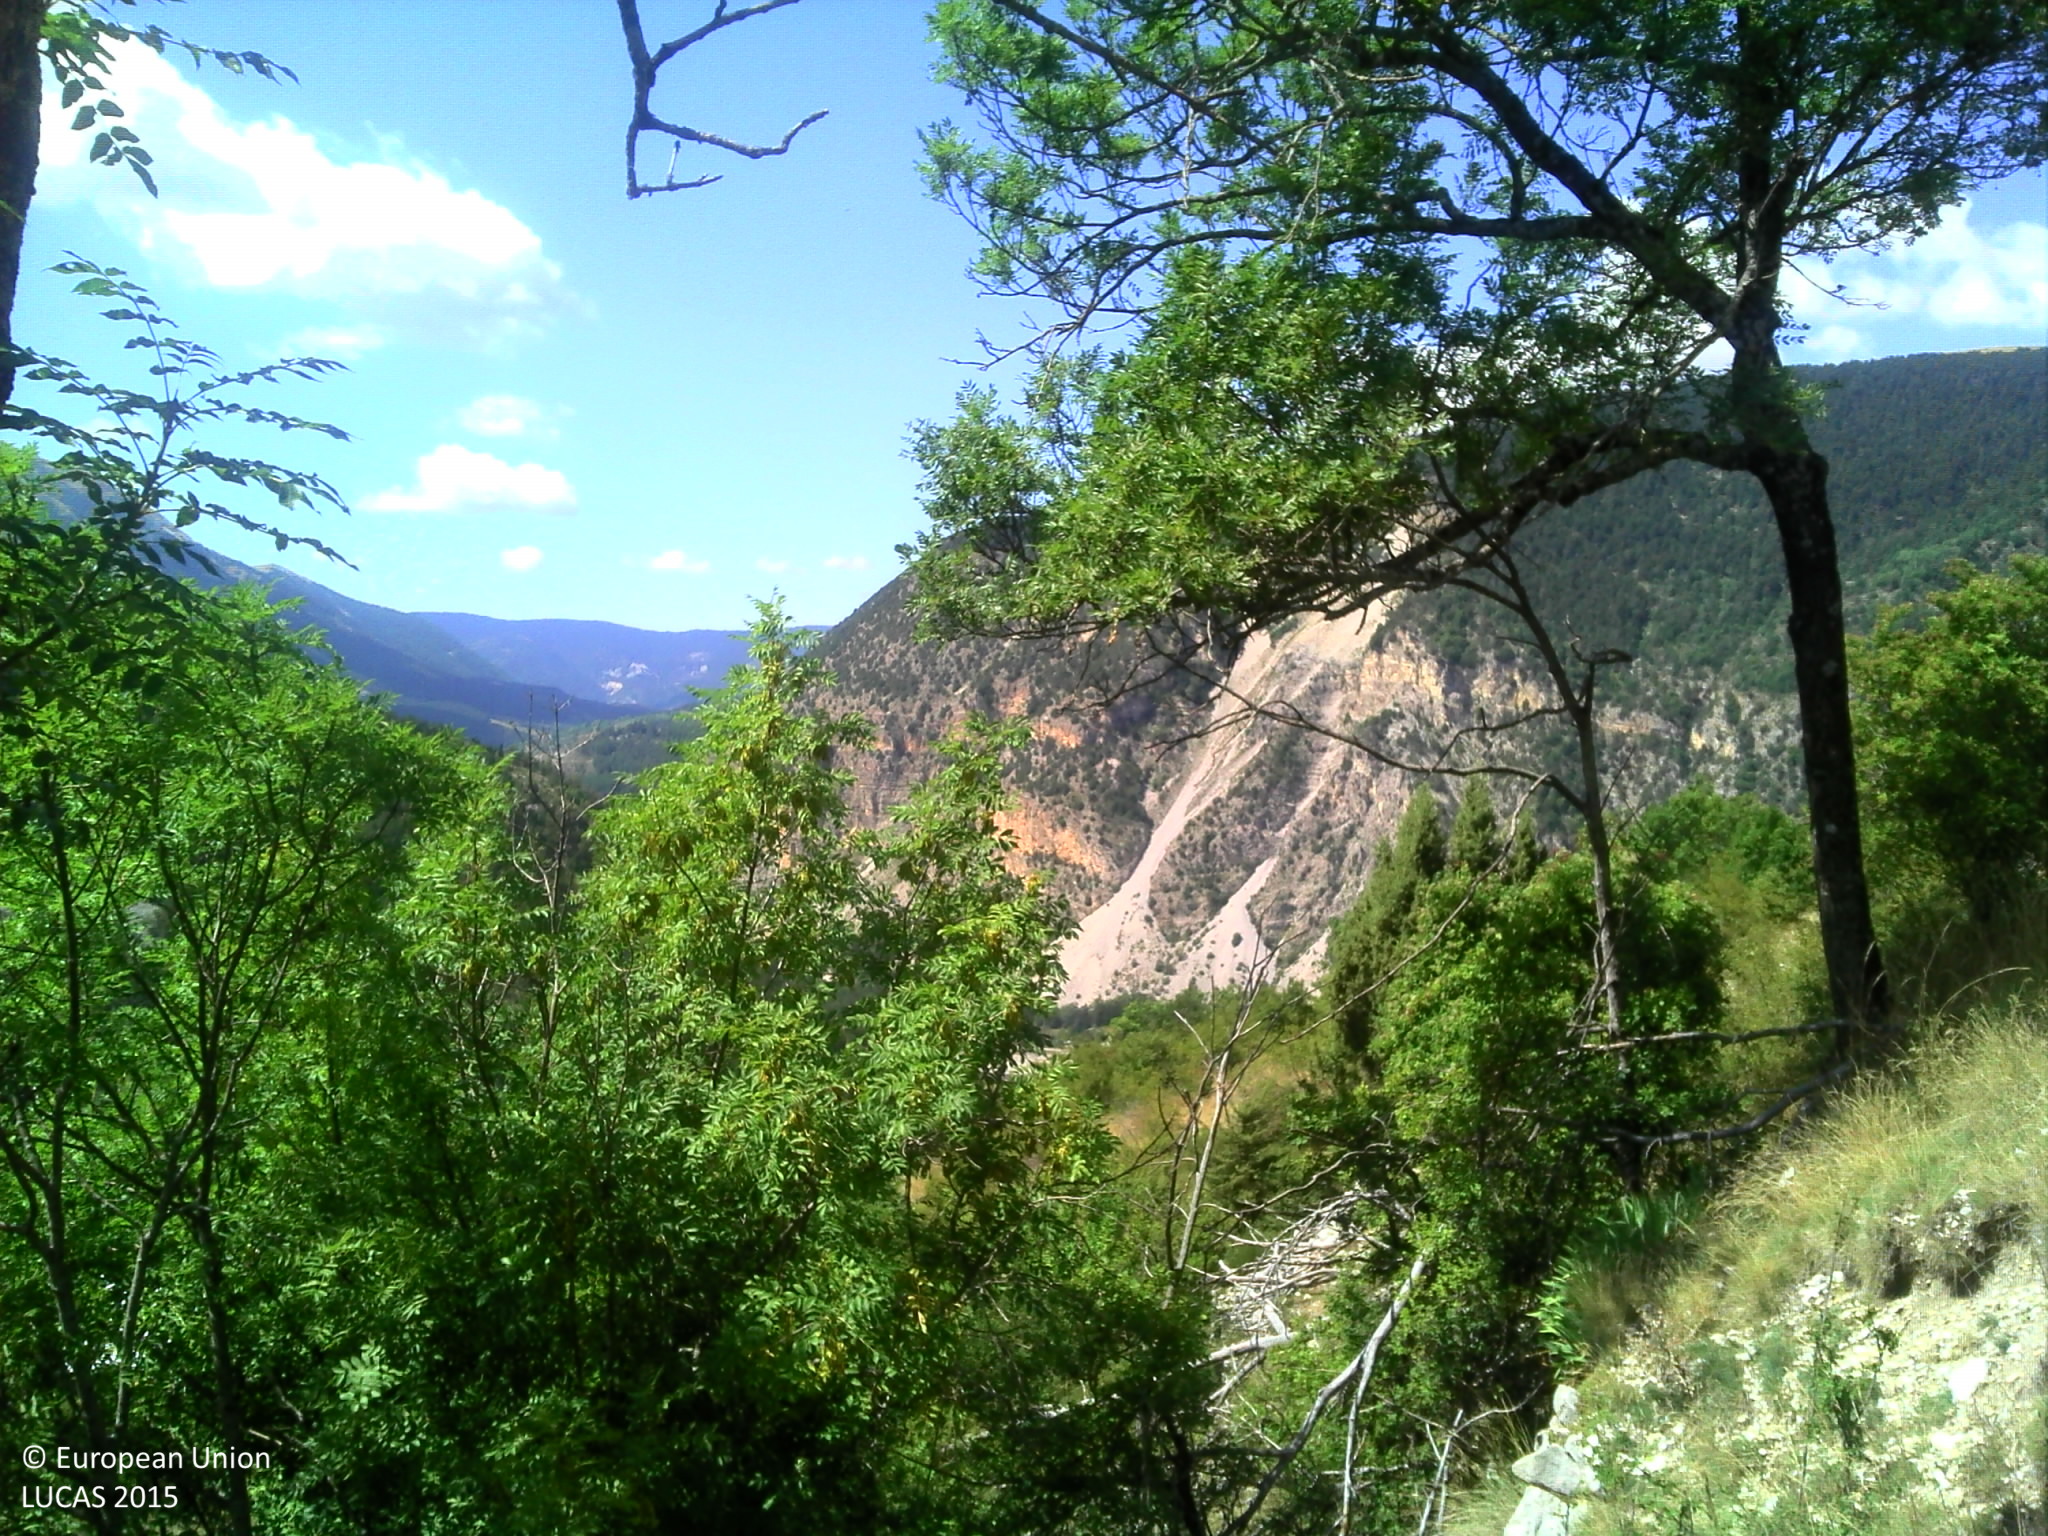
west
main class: Woodland
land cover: Broadleaved woodland
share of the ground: 25 - 50 %
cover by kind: broadleaved forest trees 40 %, shrubs 30 %, herbaceous plants 20 %, unconsolidated bare surface 10 %
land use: Semi-natural and natural areas not in use
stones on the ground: < 10 %
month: August
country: FR
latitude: 44.1142
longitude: 6.5960
